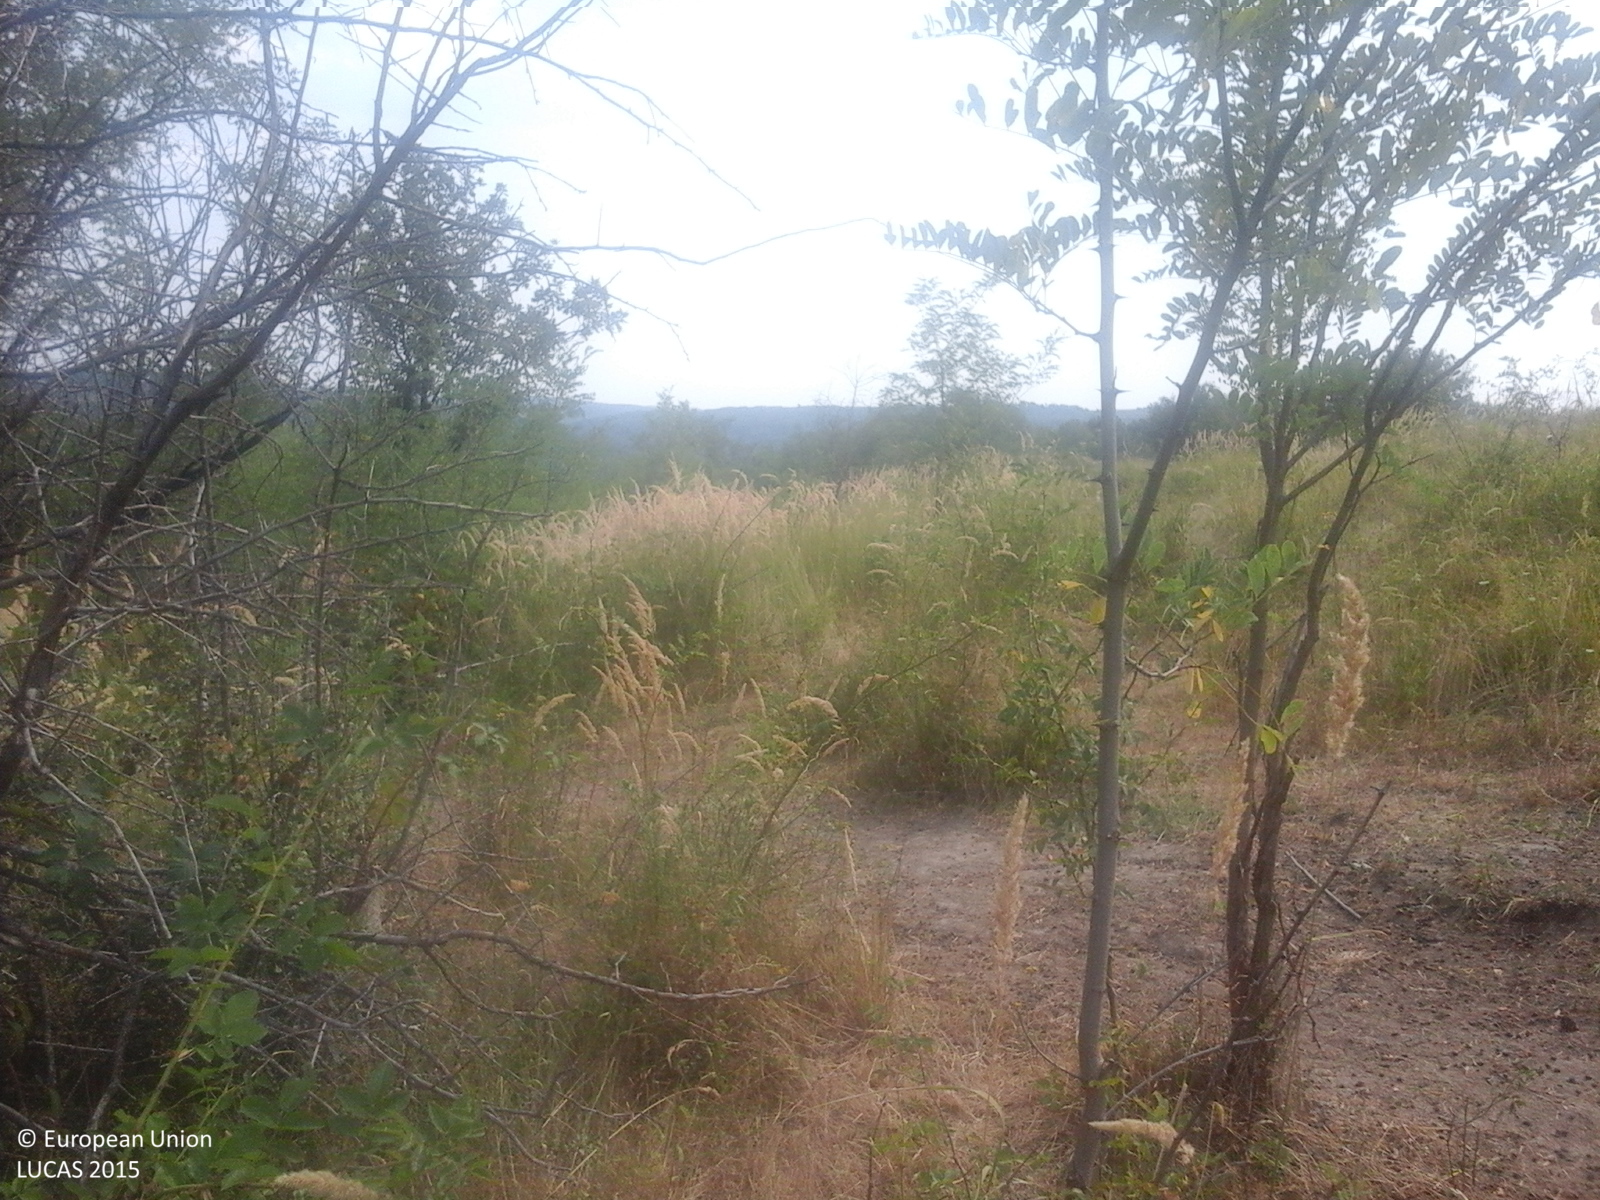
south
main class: Woodland
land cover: Broadleaved woodland
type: exotic forest
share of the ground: > 75 %
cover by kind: broadleaved forest trees 100 %
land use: Forestry
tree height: > 5 m
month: August
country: RO
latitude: 44.8601
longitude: 23.7147
